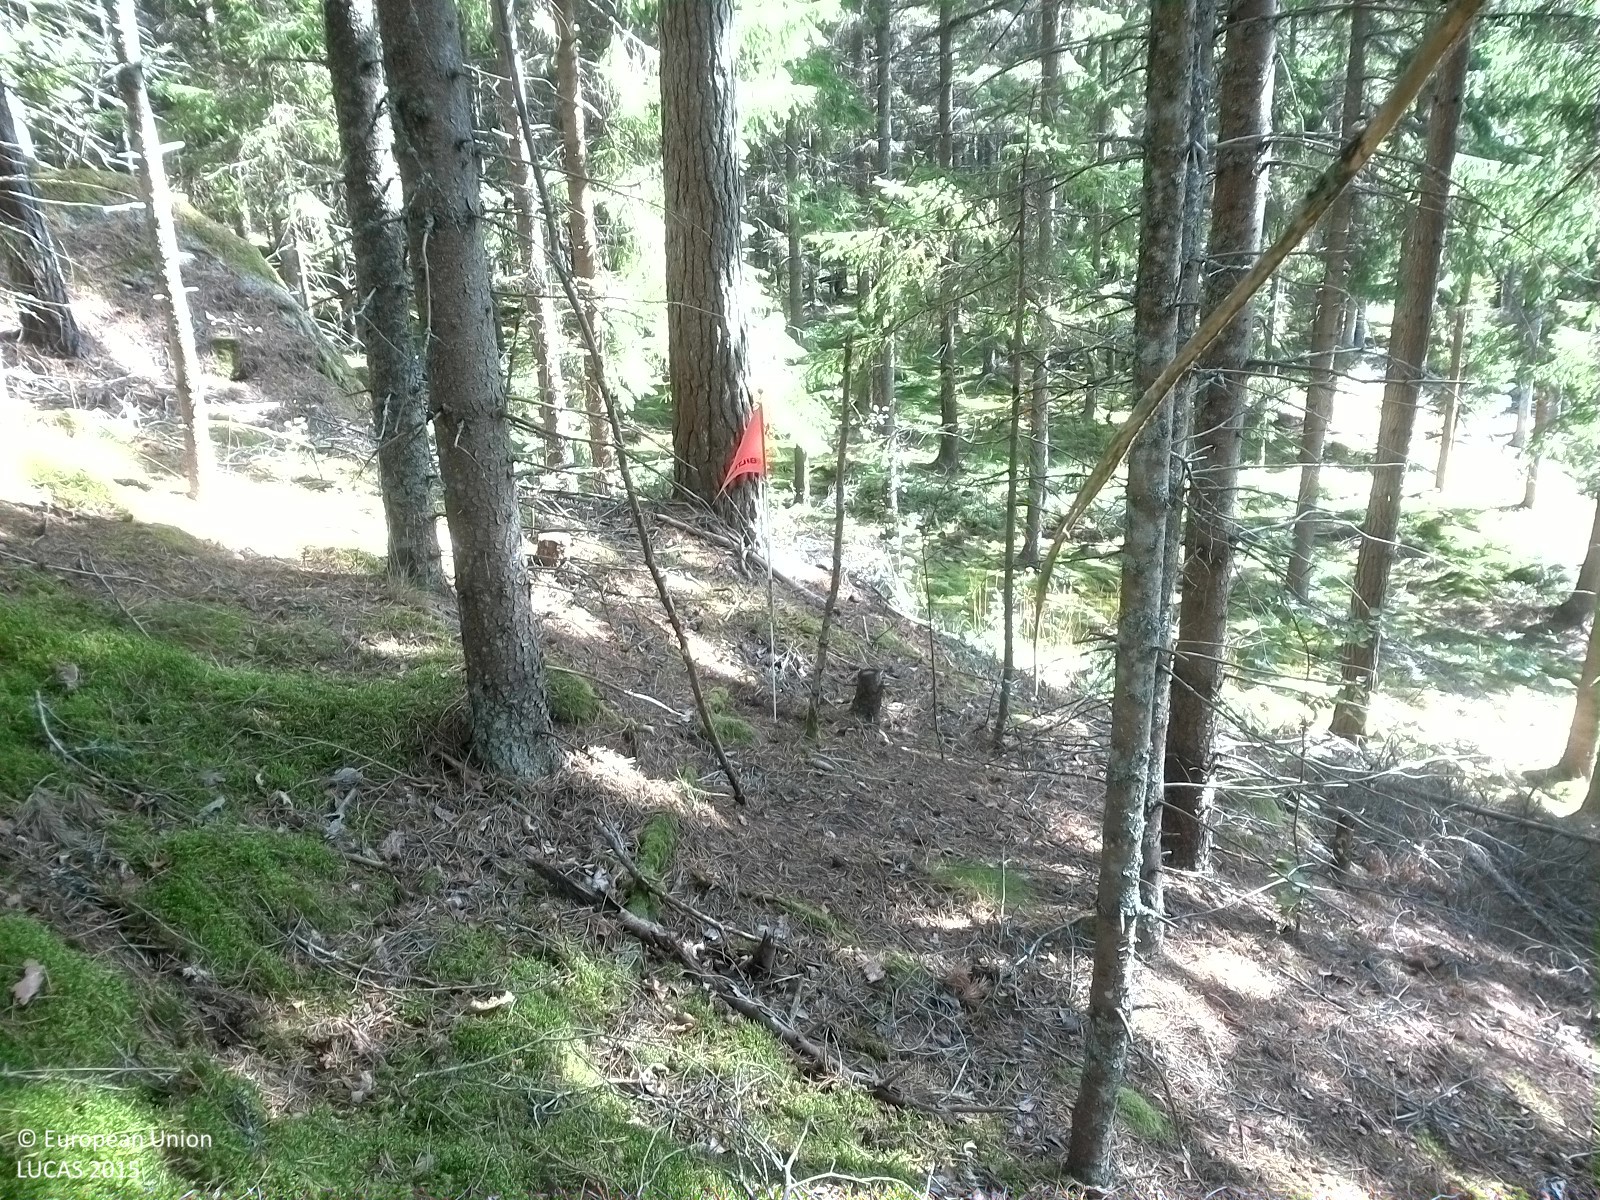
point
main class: Woodland
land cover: Other coniferous woodland
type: boreal forest
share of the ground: 25 - 50 %
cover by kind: coniferous forest trees 40 %, lichens and mosses 30 %, unconsolidated bare surface 20 %, broadleaved forest trees 5 %, herbaceous plants 5 %
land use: Forestry
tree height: > 5 m
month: August
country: SE
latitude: 58.6298
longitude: 15.0397
